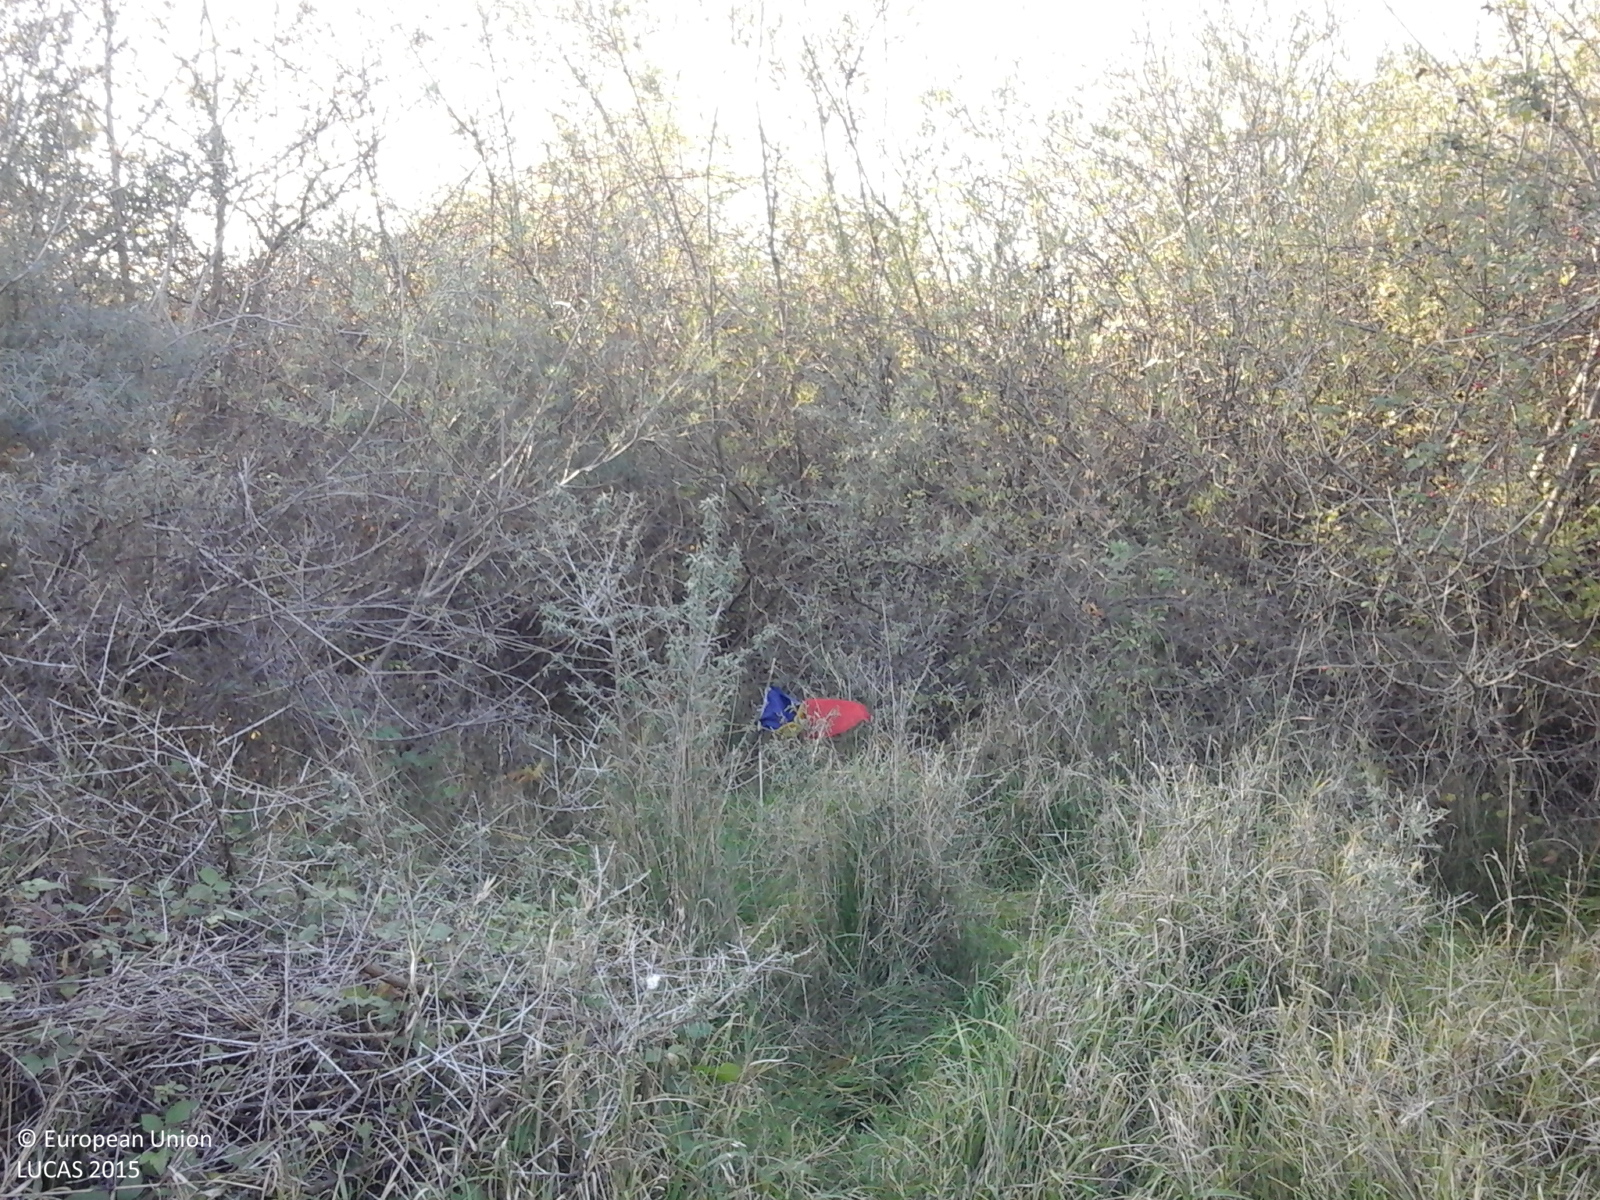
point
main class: Shrubland
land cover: Shrubland without tree cover
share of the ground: > 75 %
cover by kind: shrubs 100 %
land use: Semi-natural and natural areas not in use
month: October
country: RO
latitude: 45.2153
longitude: 26.6683
